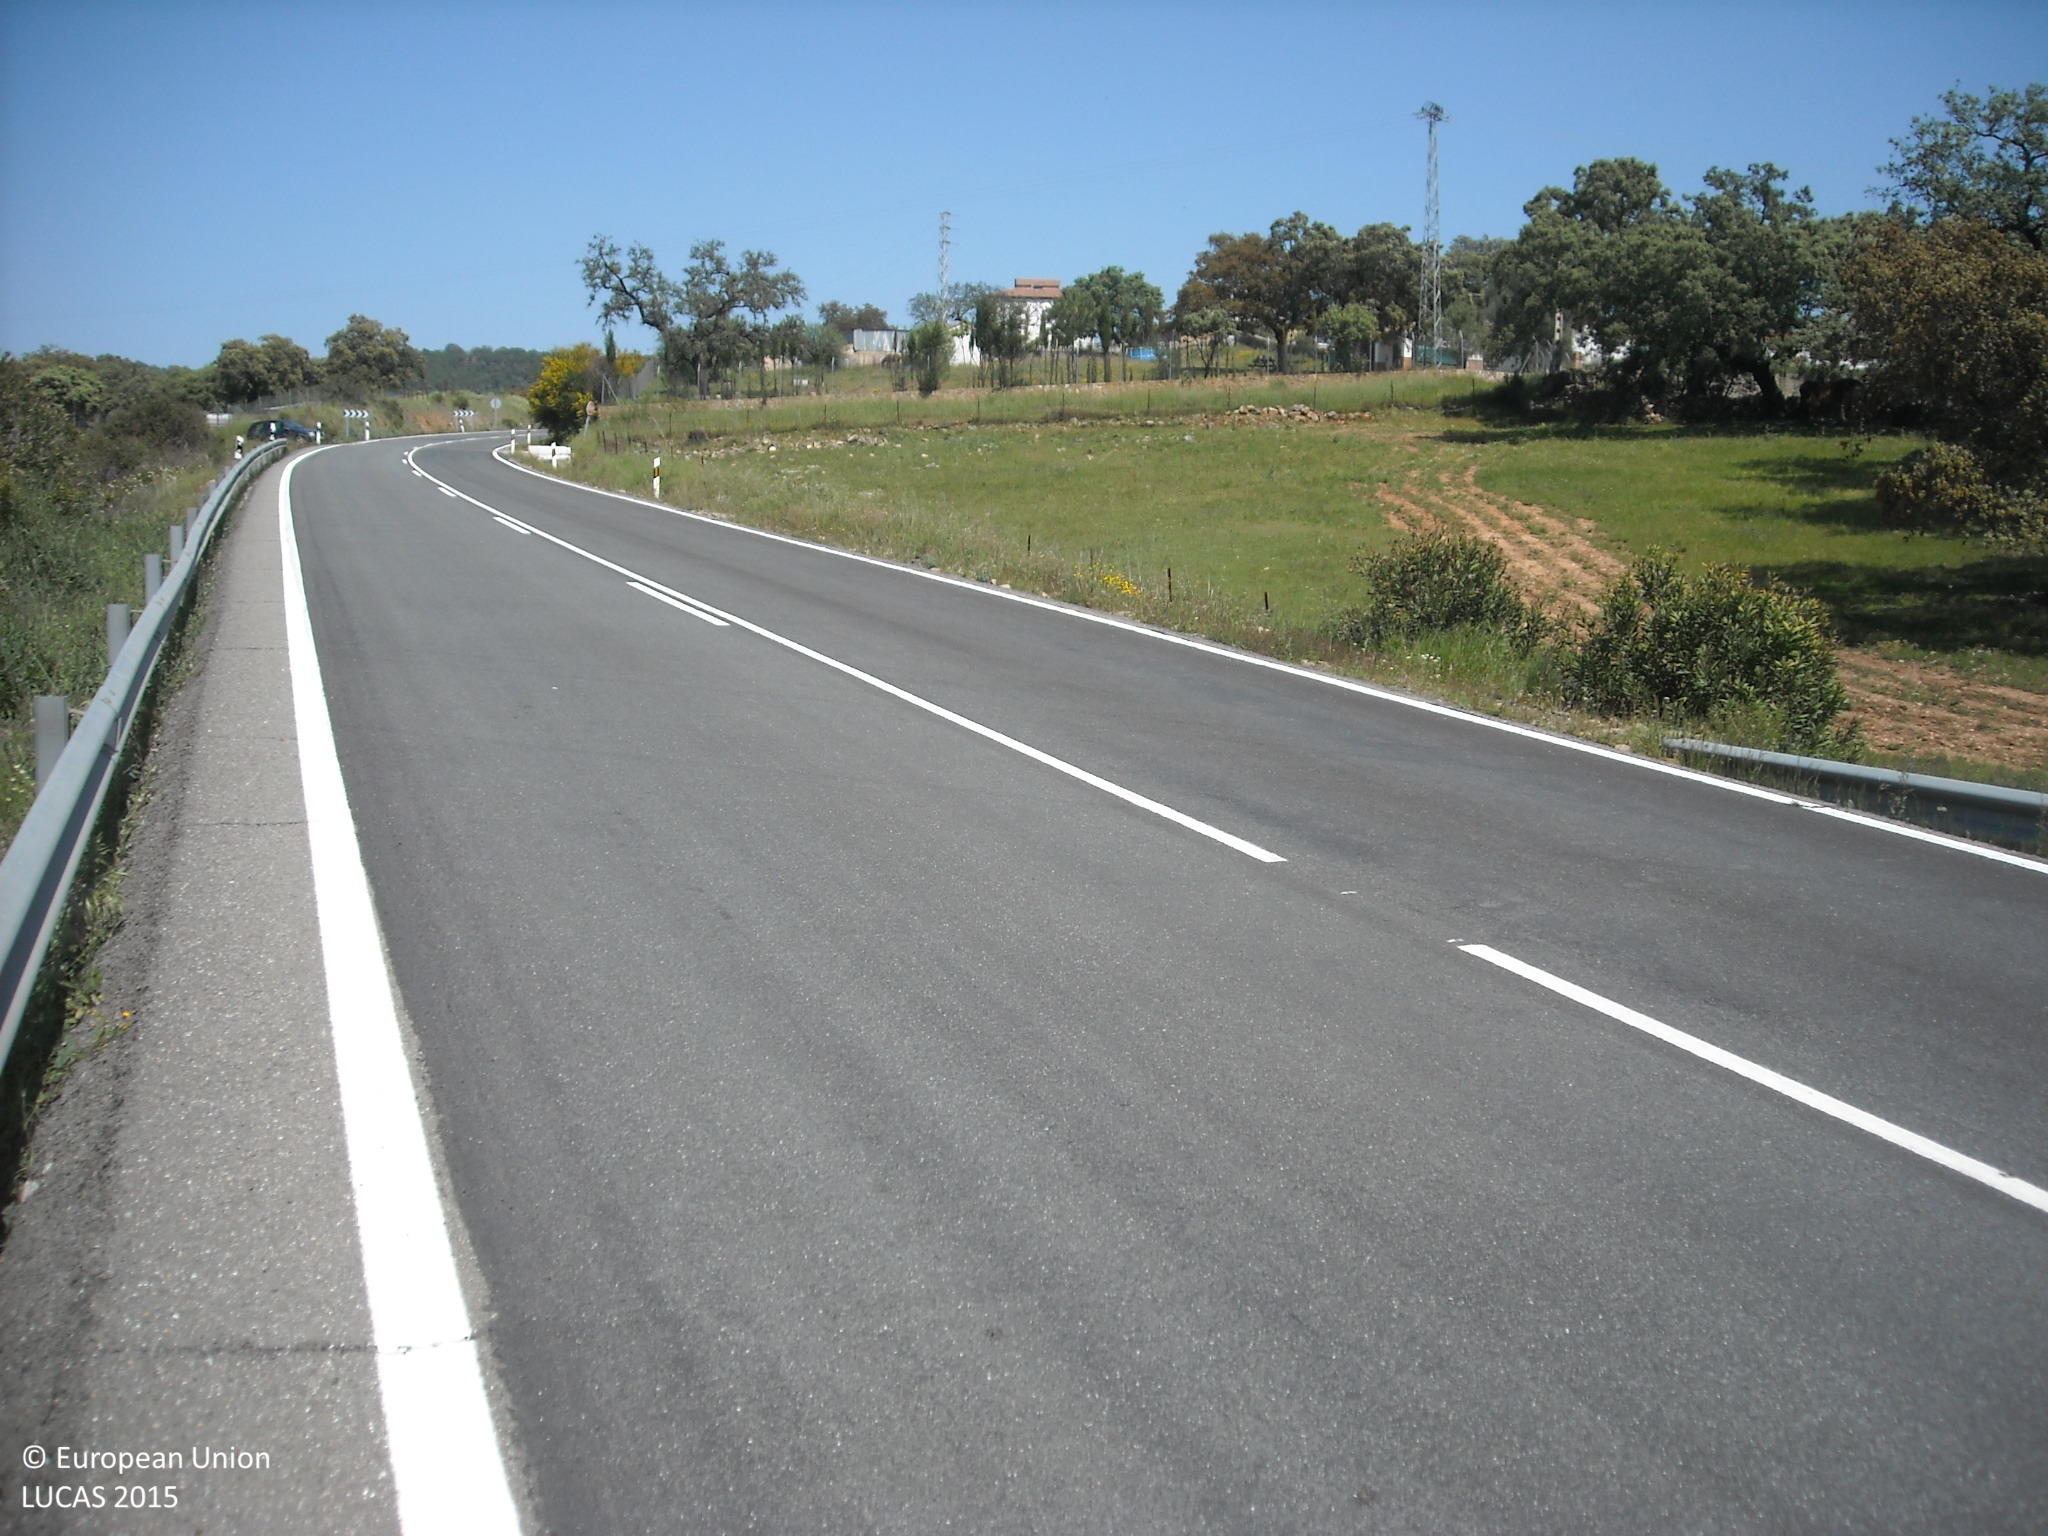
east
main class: Woodland
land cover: Broadleaved woodland
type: broadleaved evergreen forest
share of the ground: 25 - 50 %
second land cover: Grassland without tree/shrub cover
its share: > 75 %
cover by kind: herbaceous plants 75 %, broadleaved forest trees 25 %
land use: Forestry
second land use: Agriculture (excluding fallow land and kitchen gardens)
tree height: > 5 m
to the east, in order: Broadleaved woodland; Grassland without tree/shrub cover; Inland fresh running water; Broadleaved woodland; Shrubland without tree cover; Electric lines; Shrubland without tree cover; Fences; Grass margins; Paved roads, cycling and walking lanes; Grass margins; Fences; Shrubland without tree cover; Grassland without tree/shrub cover; Fences; Grassland without tree/shrub cover; Fences; Grassland without tree/shrub cover; Electric lines; Paved roads, cycling and walking lanes; Broadleaved woodland; Artificial constructions in urban areas
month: April
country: ES
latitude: 37.7695
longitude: -6.5125
